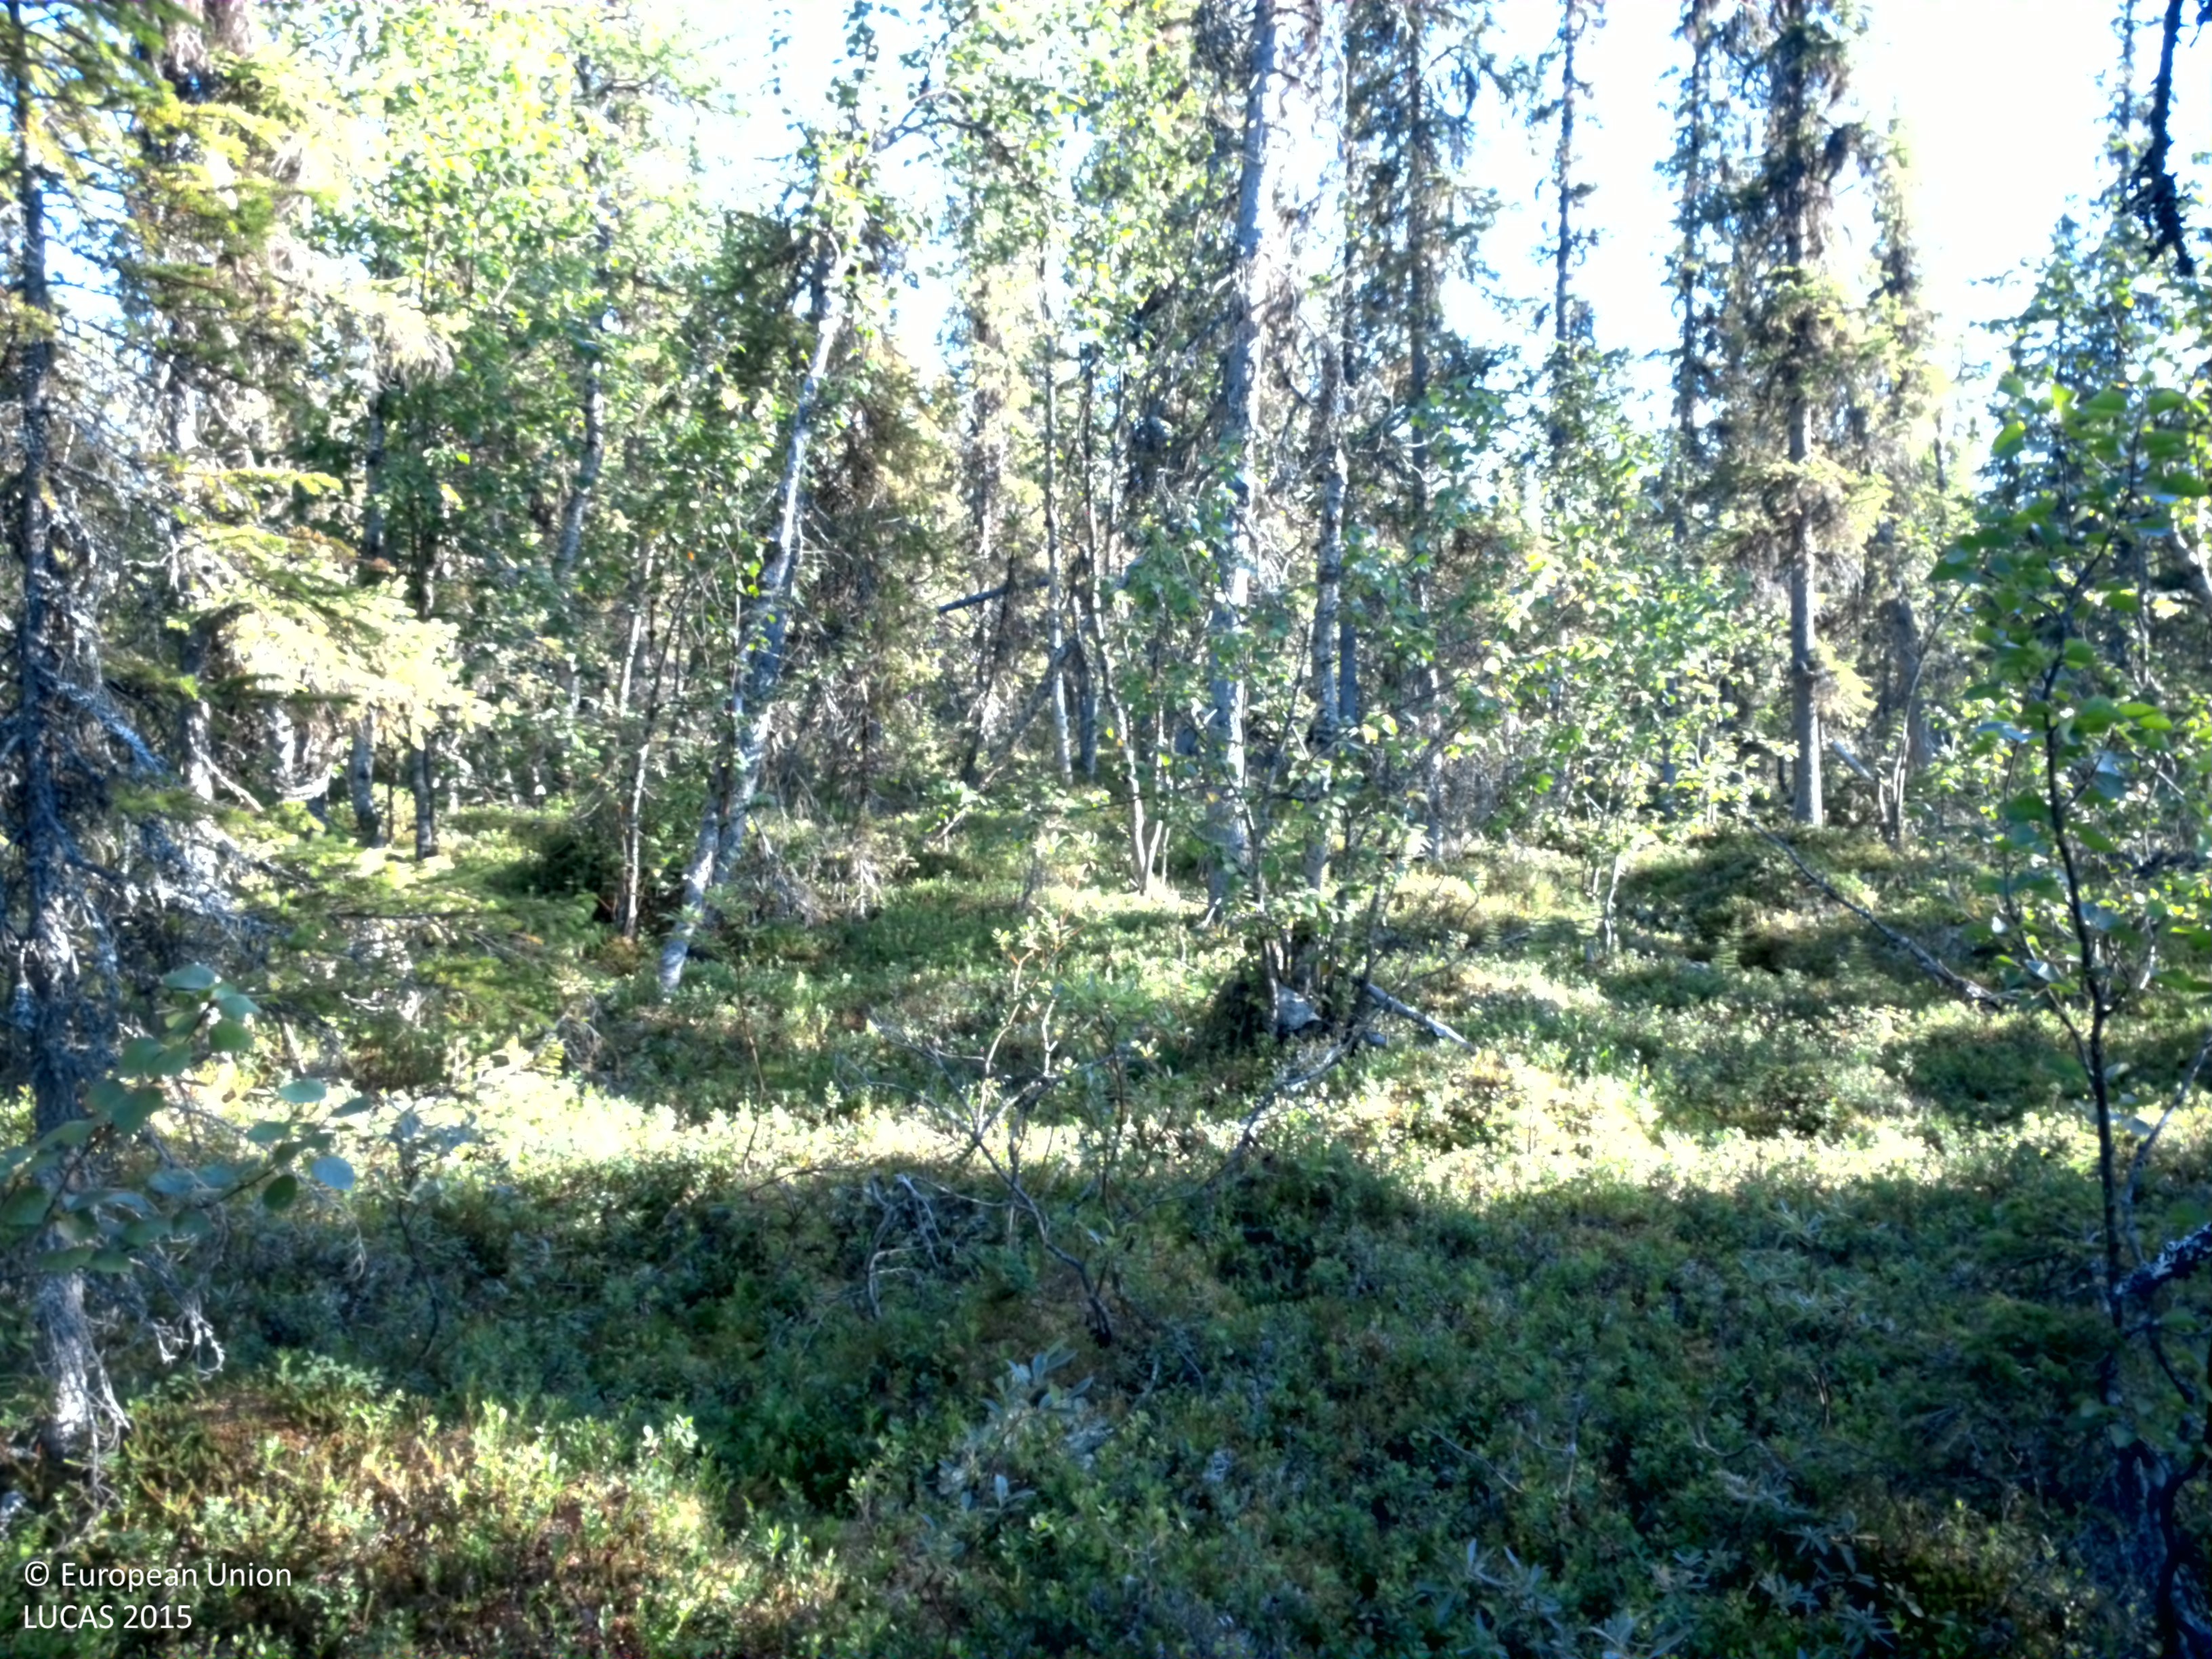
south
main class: Woodland
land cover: Pine dominated mixed woodland
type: boreal forest
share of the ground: 25 - 50 %
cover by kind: shrubs 60 %, coniferous forest trees 30 %, broadleaved forest trees 10 %
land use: Amenities, museums, leisure
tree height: > 5 m
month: August
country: SE
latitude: 66.9356
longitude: 18.8908
